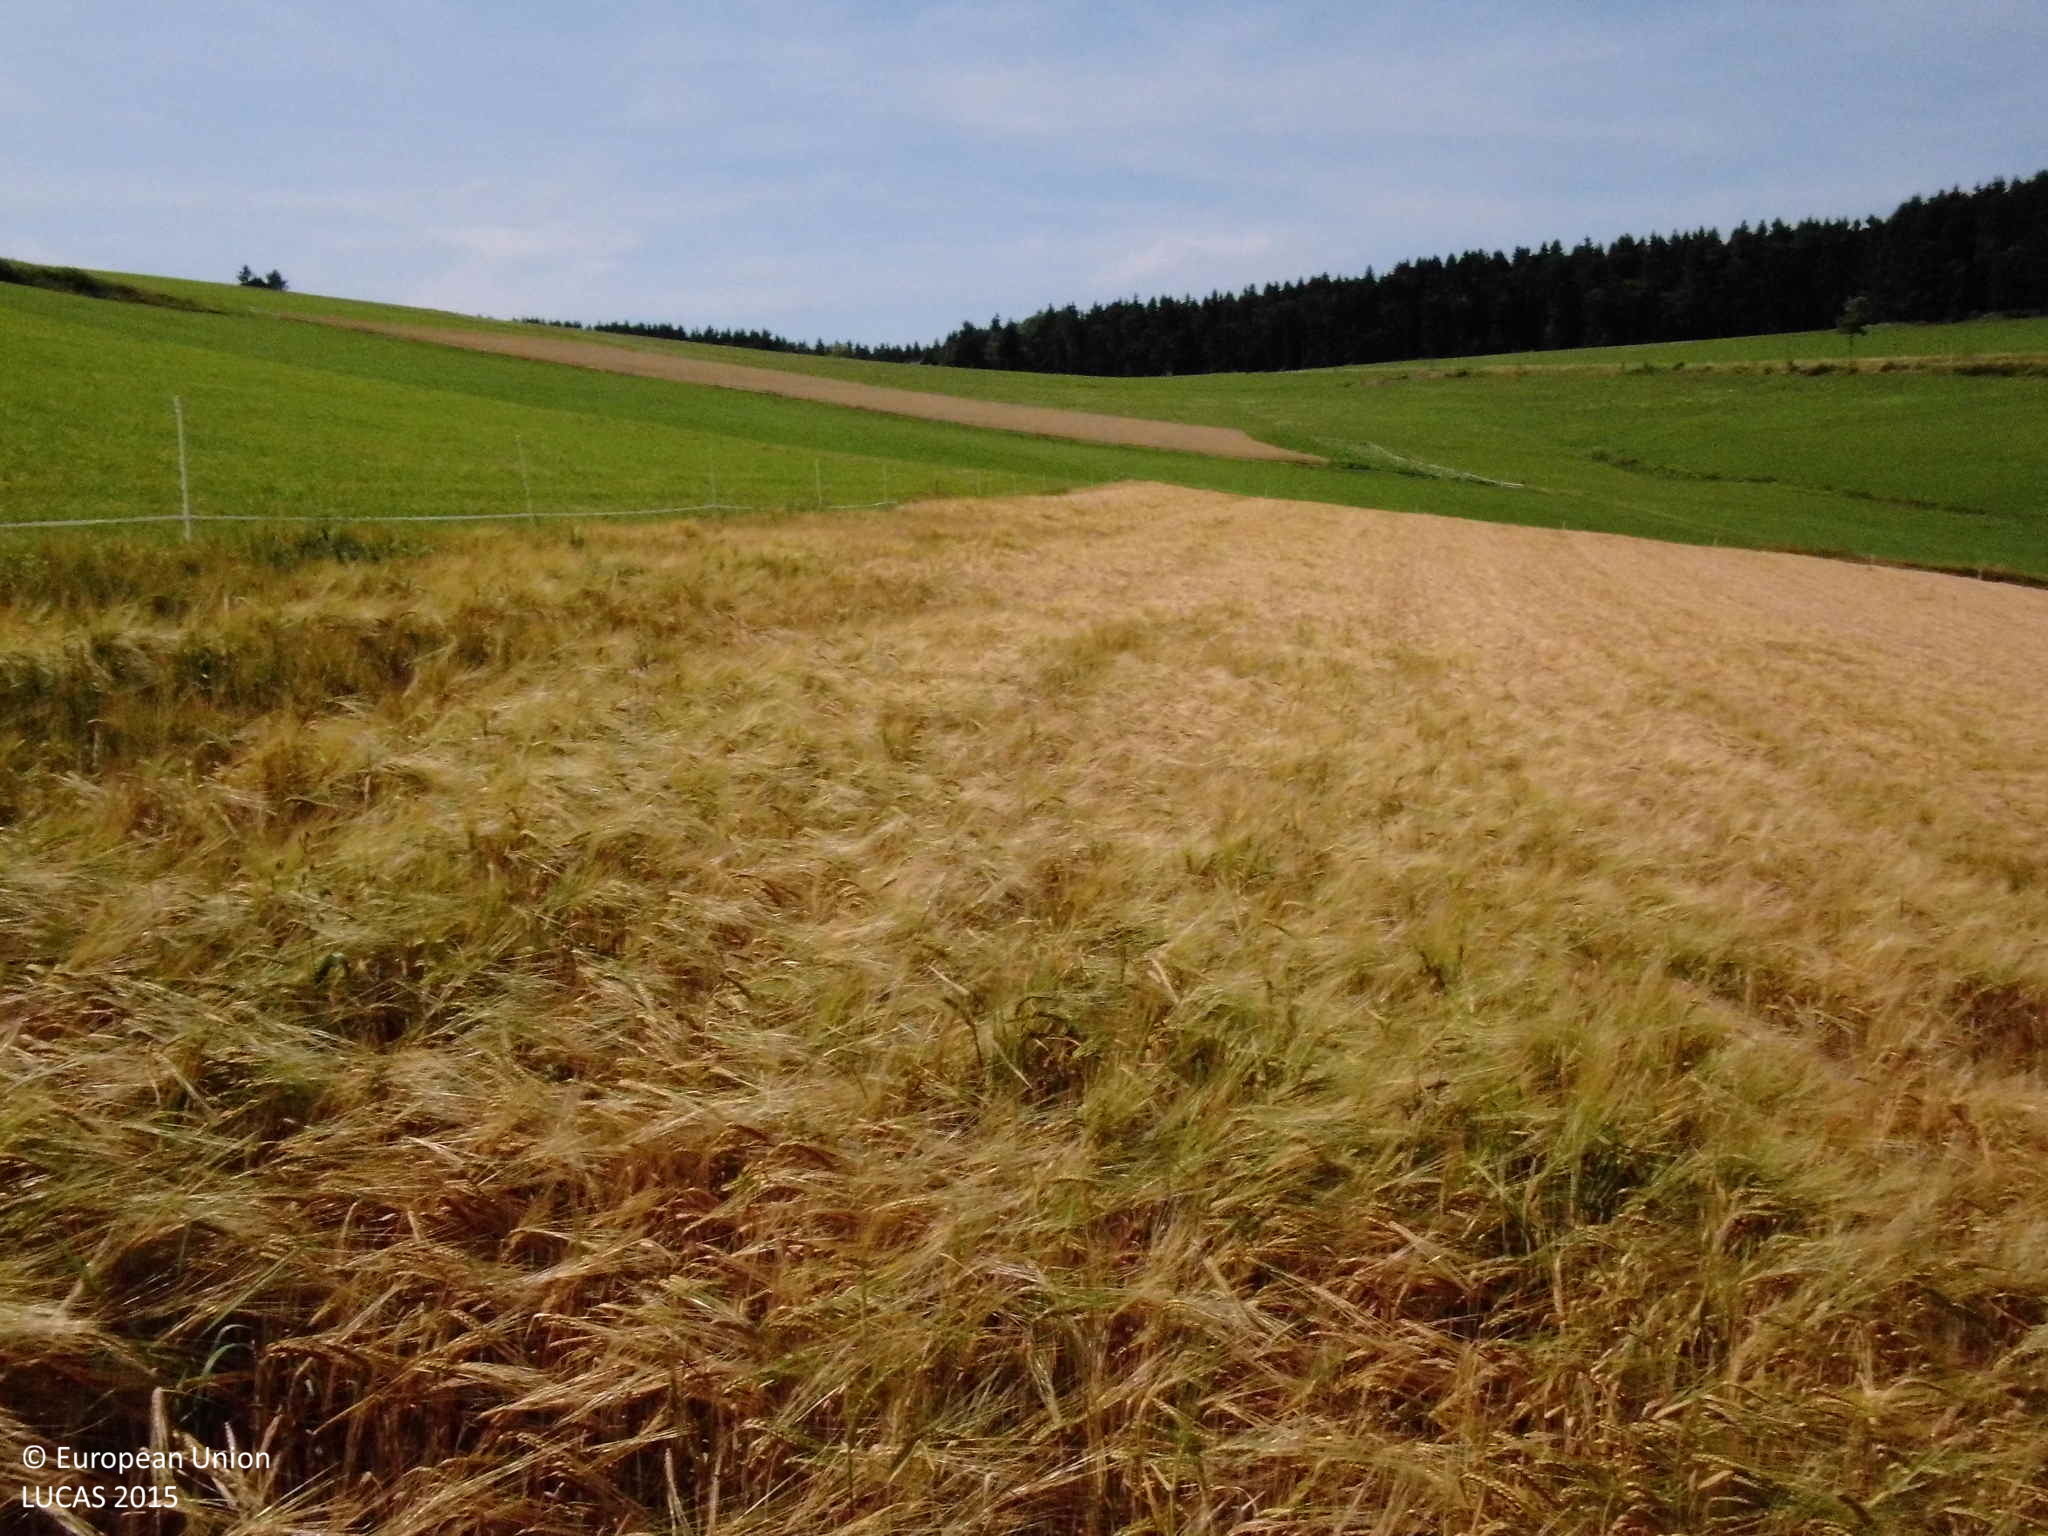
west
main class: Cropland
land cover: Barley
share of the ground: > 75 %
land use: Agriculture (excluding fallow land and kitchen gardens)
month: August
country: DE
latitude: 51.0732
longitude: 8.4732
